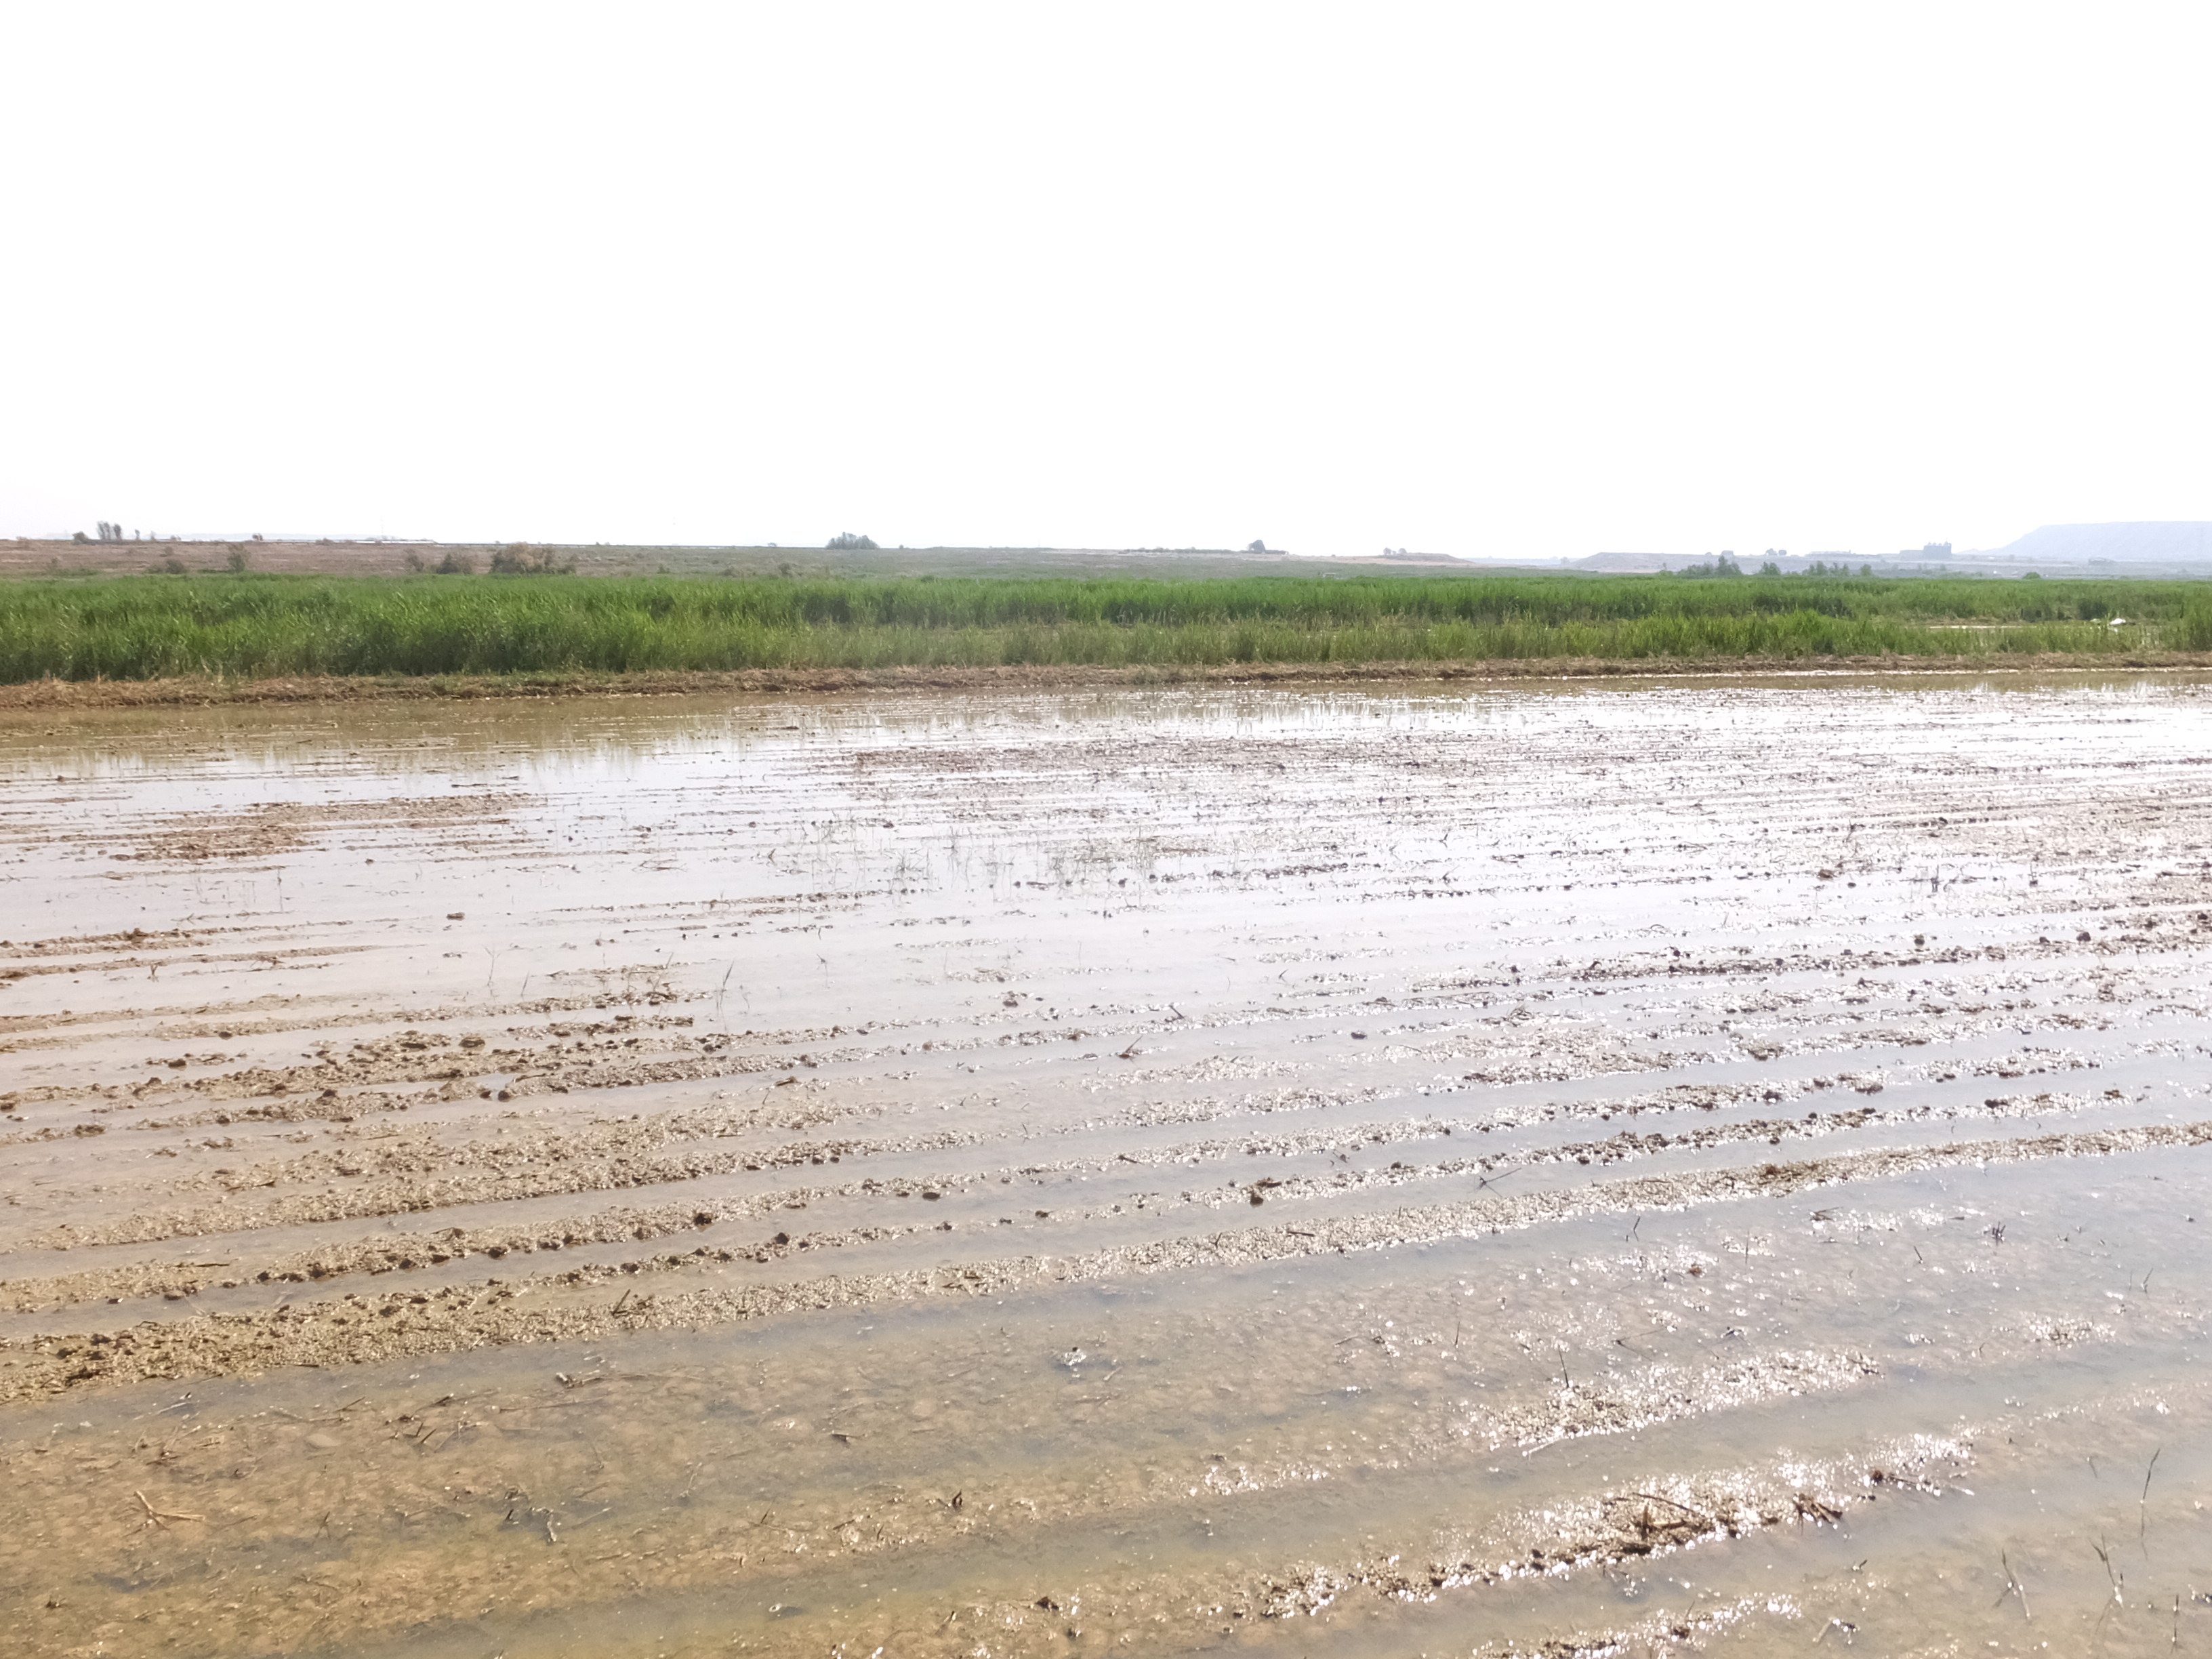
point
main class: Cropland
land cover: Rice
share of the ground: < 10 %
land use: Agriculture (excluding fallow land and kitchen gardens)
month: June
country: ES
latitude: 41.7280
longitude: 0.0660
